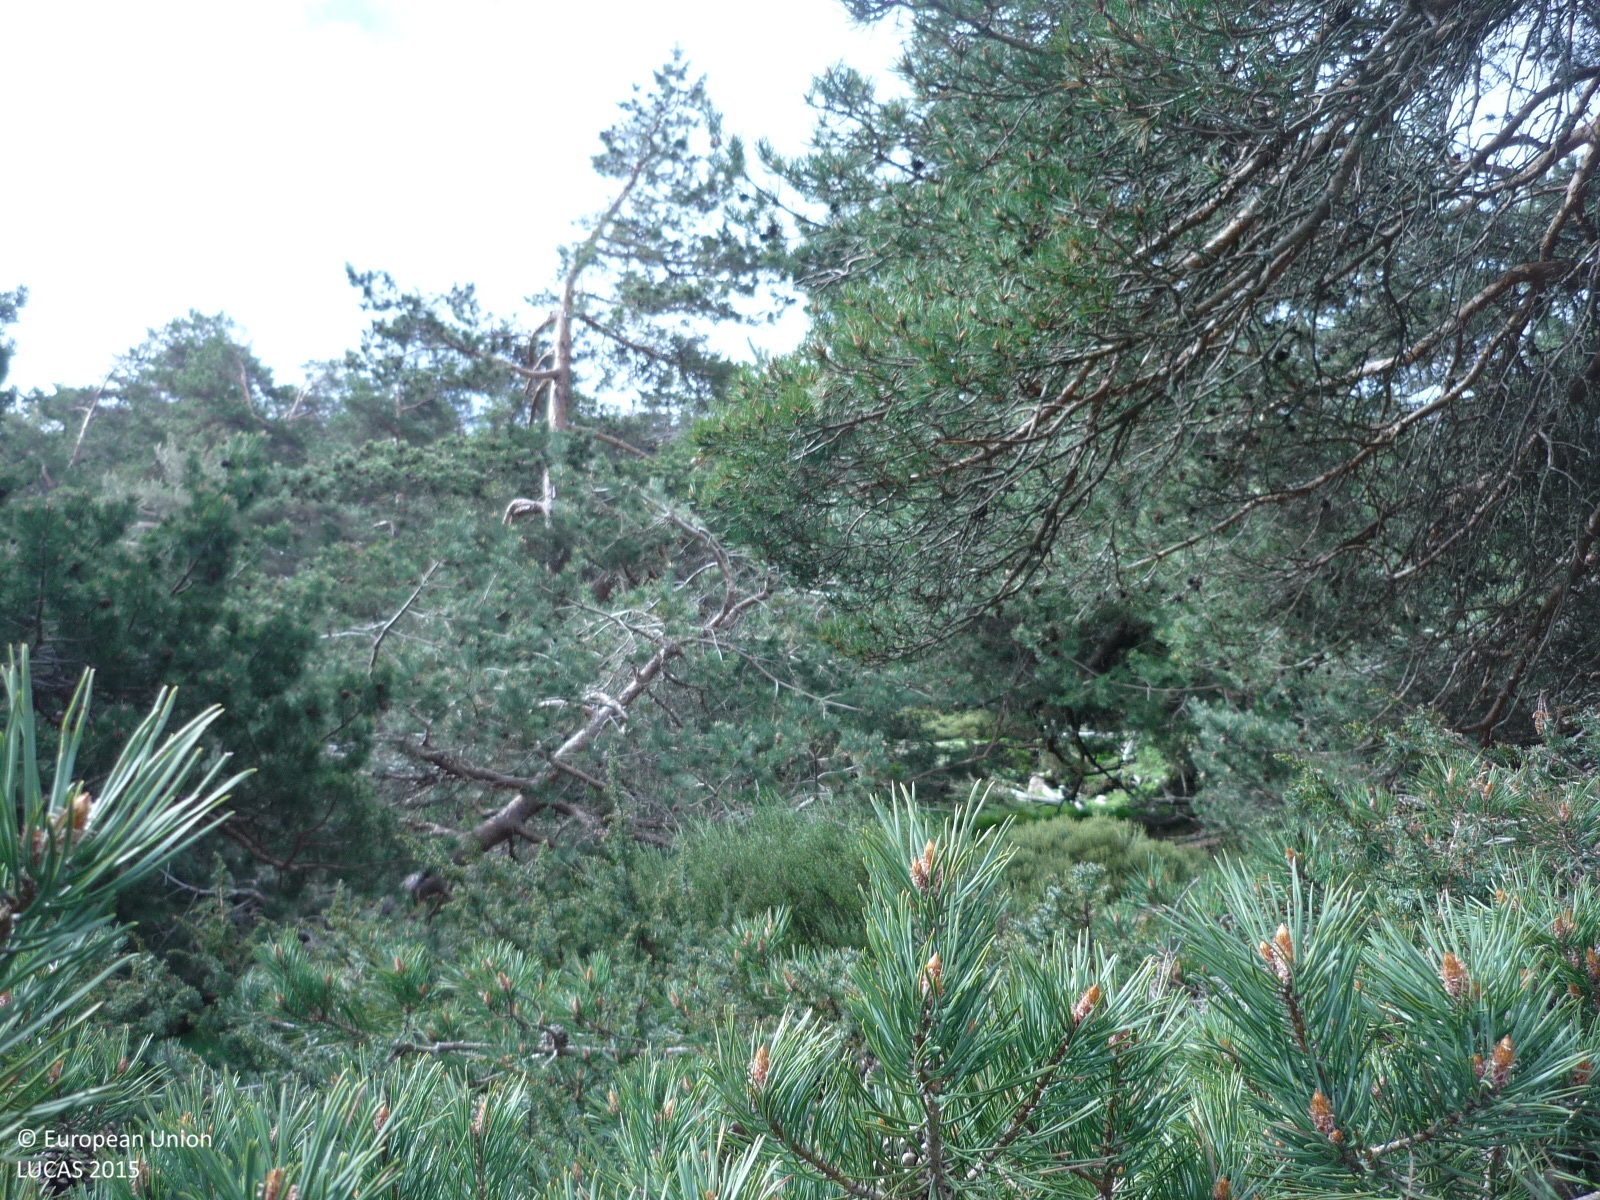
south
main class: Woodland
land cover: Pine dominated coniferous woodland
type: coniferous forest of the mediterranean region
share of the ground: 50 - 75 %
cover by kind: coniferous forest trees 60 %, herbaceous plants 30 %, shrubs 10 %
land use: Forestry
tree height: > 5 m
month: May
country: ES
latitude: 41.0780
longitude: -3.6980
